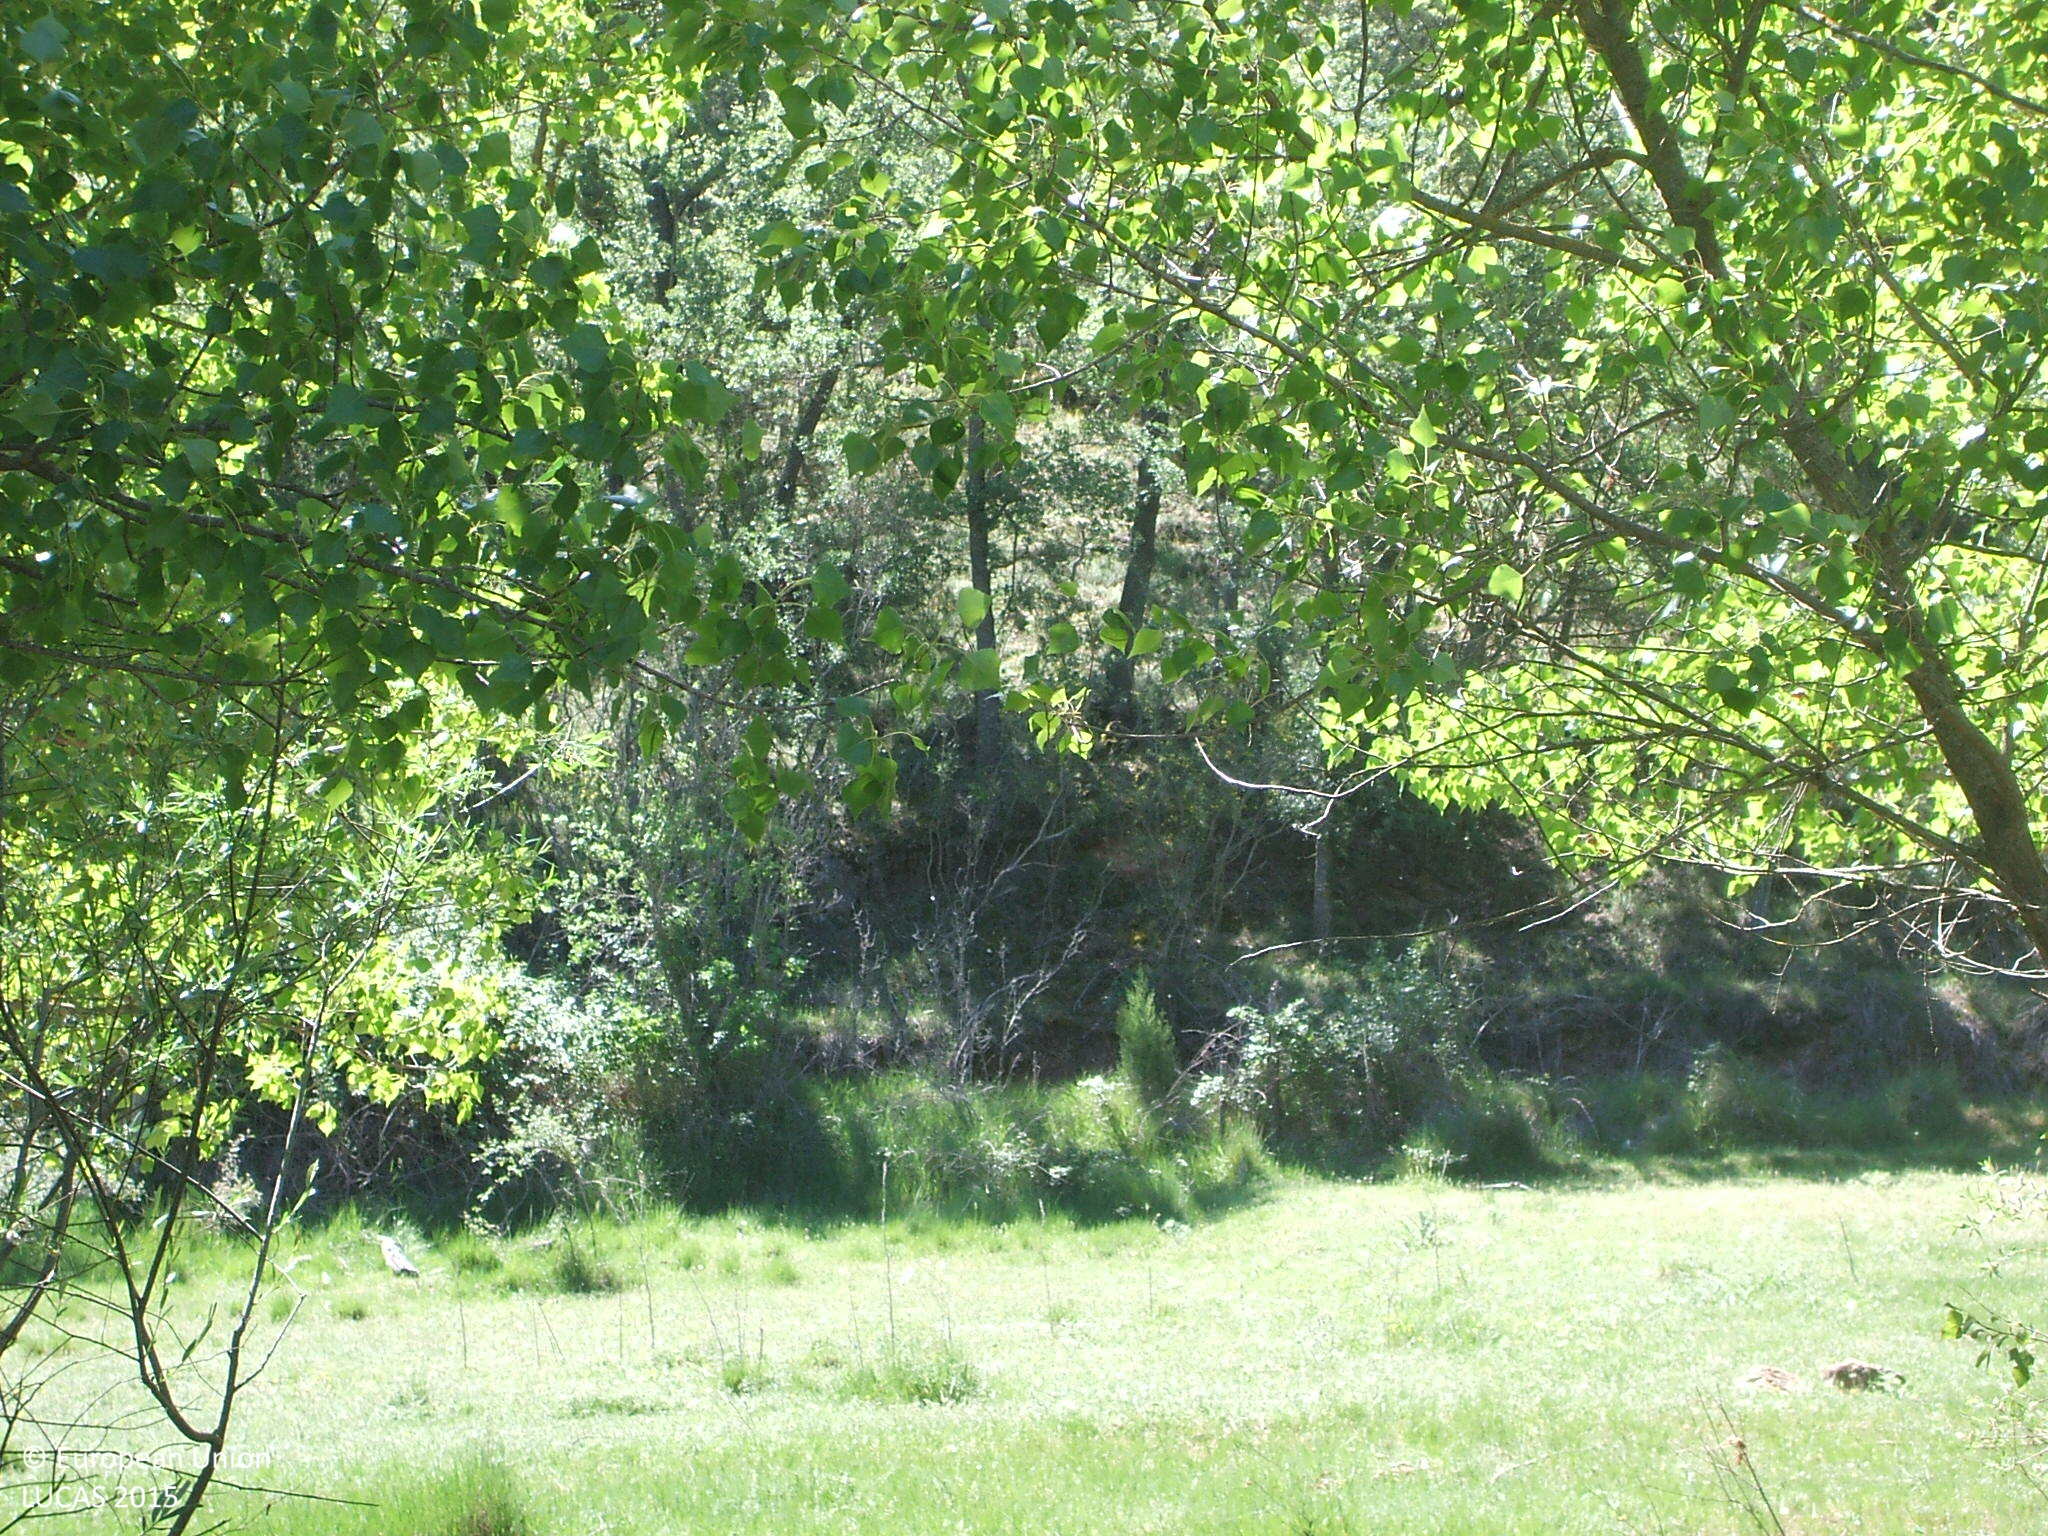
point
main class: Woodland
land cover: Broadleaved woodland
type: beech forest
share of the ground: > 75 %
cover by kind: broadleaved forest trees 100 %
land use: Semi-natural and natural areas not in use
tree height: > 5 m
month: May
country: ES
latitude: 40.0726
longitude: -0.7816
